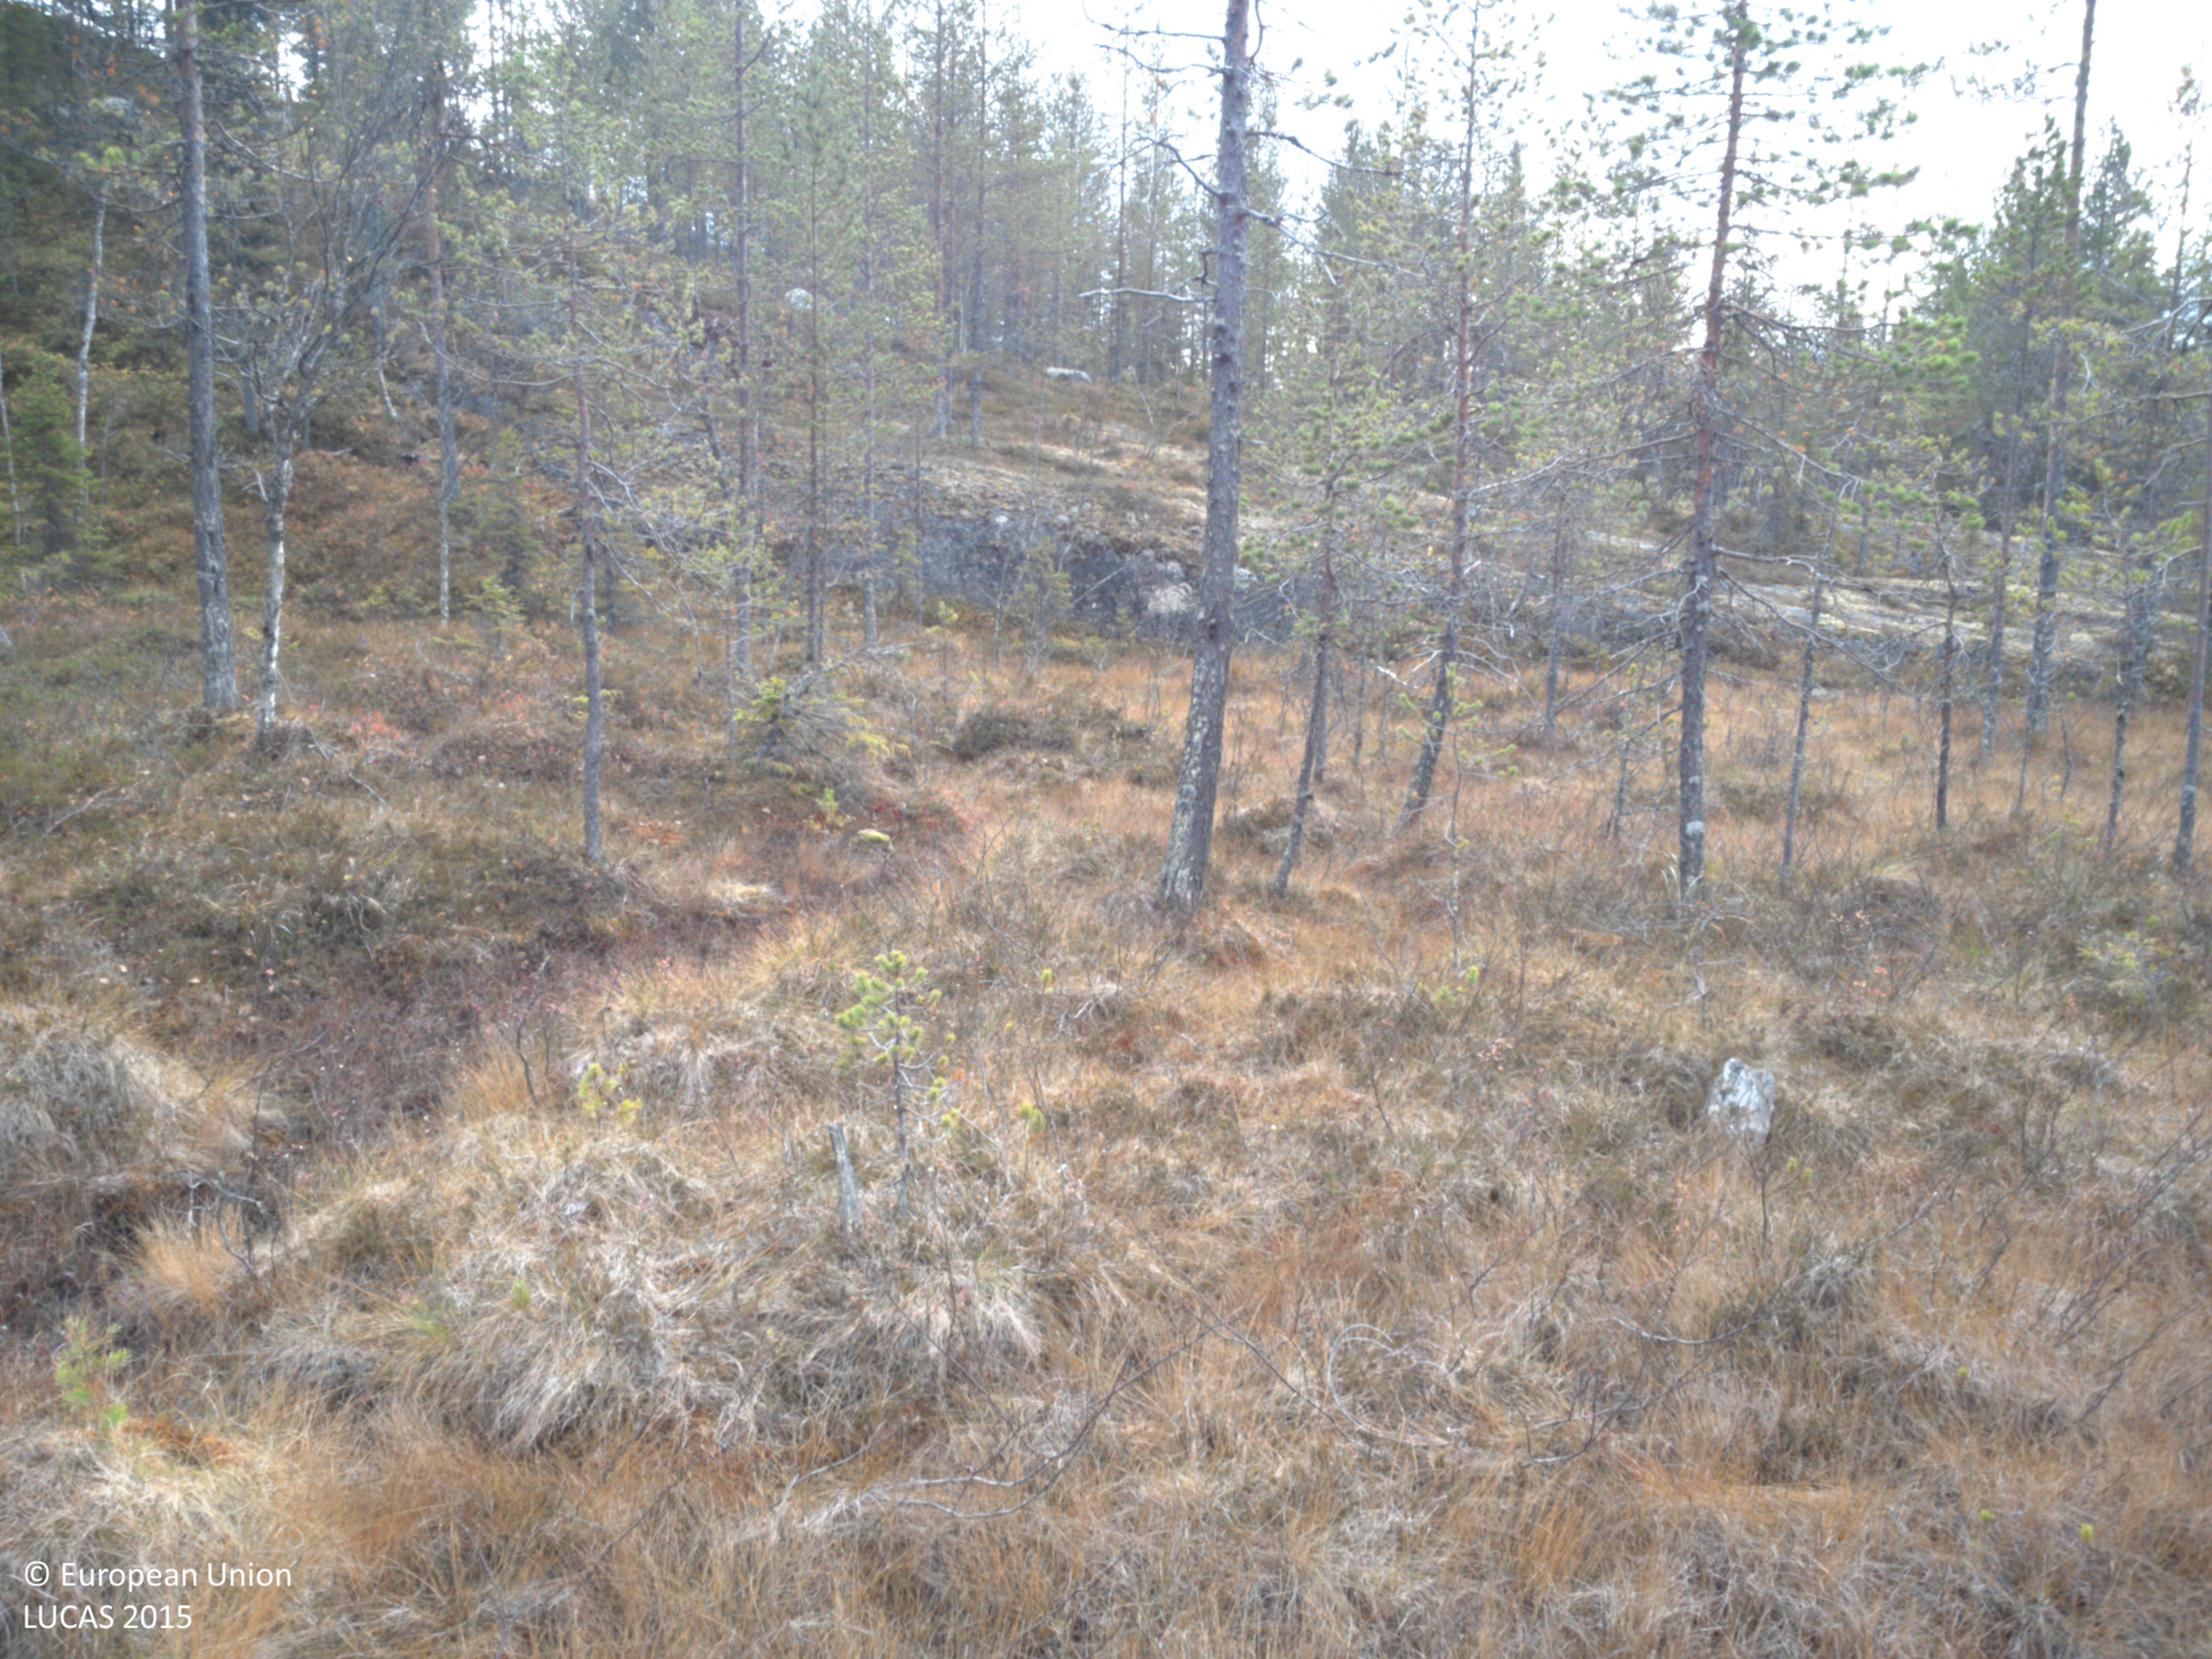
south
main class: Woodland
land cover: Pine dominated coniferous woodland
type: mire and swamp forests
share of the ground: 10 - 25 %
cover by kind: coniferous forest trees 30 %, shrubs 30 %, herbaceous plants 30 %, lichens and mosses 10 %
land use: Semi-natural and natural areas not in use
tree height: < 5 m
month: September
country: SE
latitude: 65.0015
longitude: 18.5961
